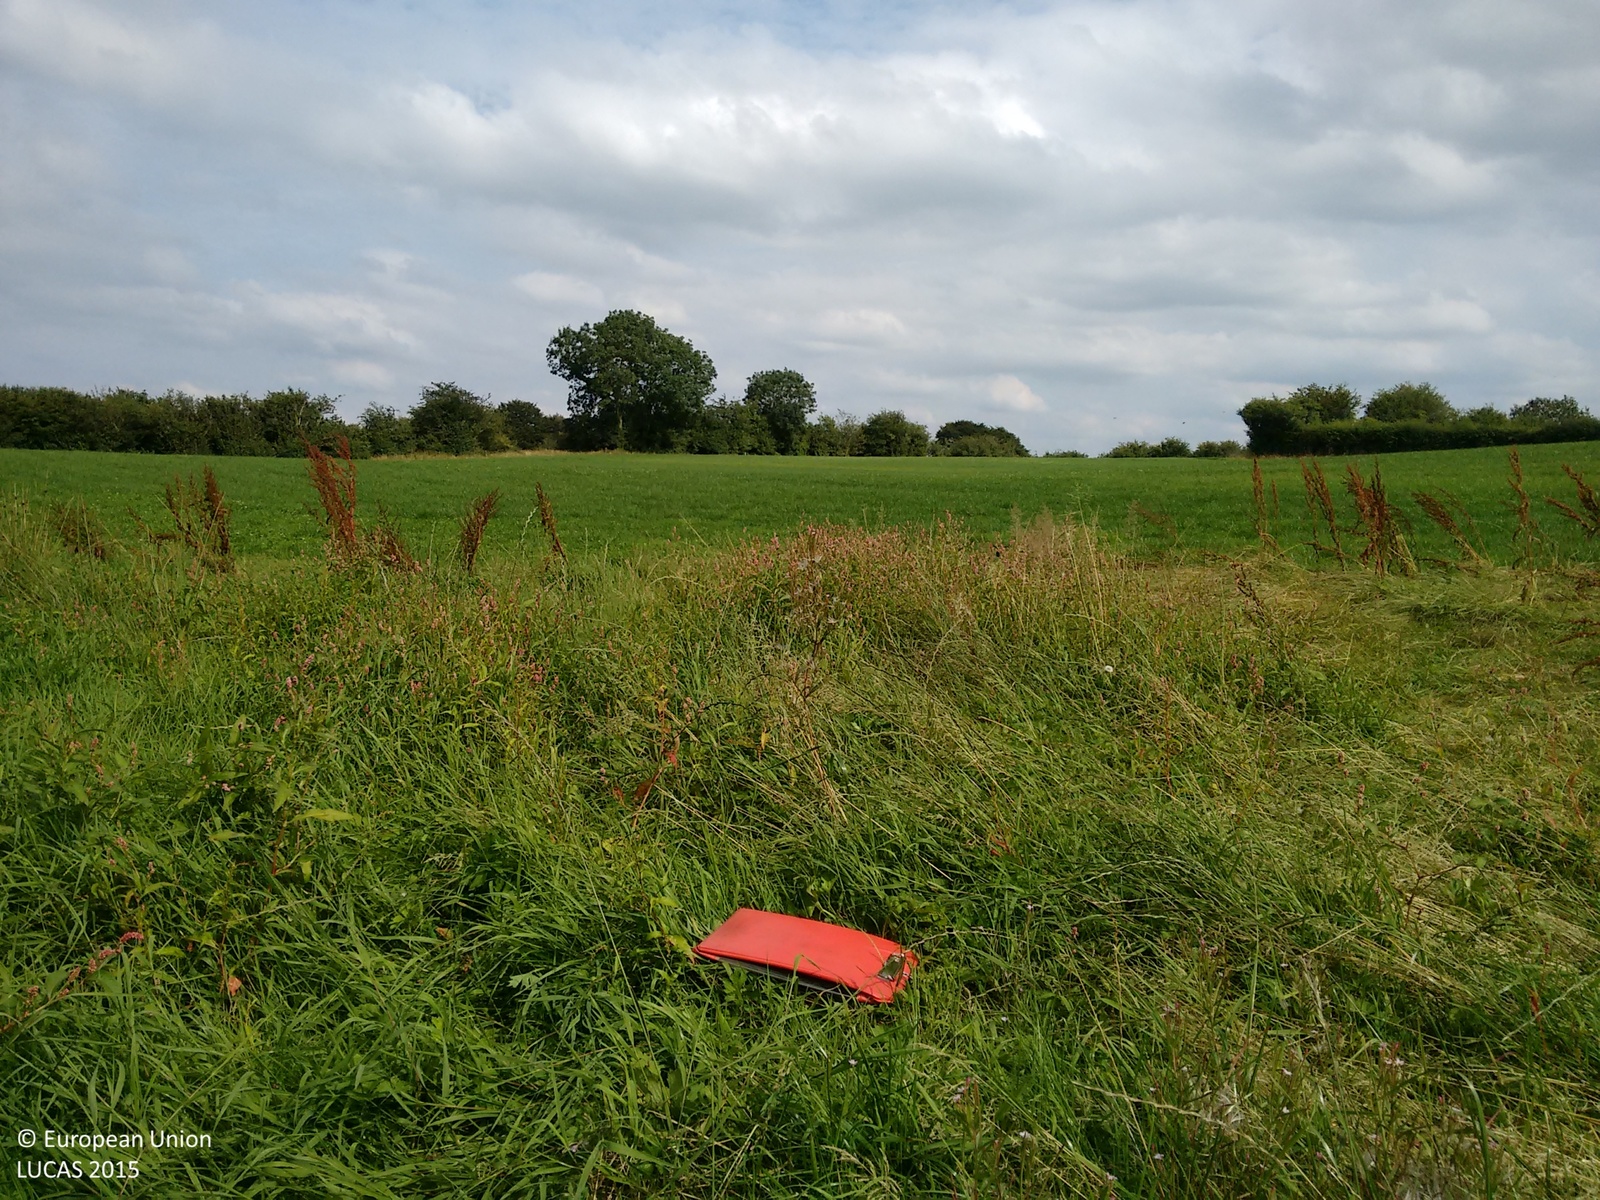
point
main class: Grassland
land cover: Grassland without tree/shrub cover
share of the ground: > 75 %
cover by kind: herbaceous plants 100 %
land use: Agriculture (excluding fallow land and kitchen gardens)
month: August
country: IE
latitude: 52.9643
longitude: -7.4728
